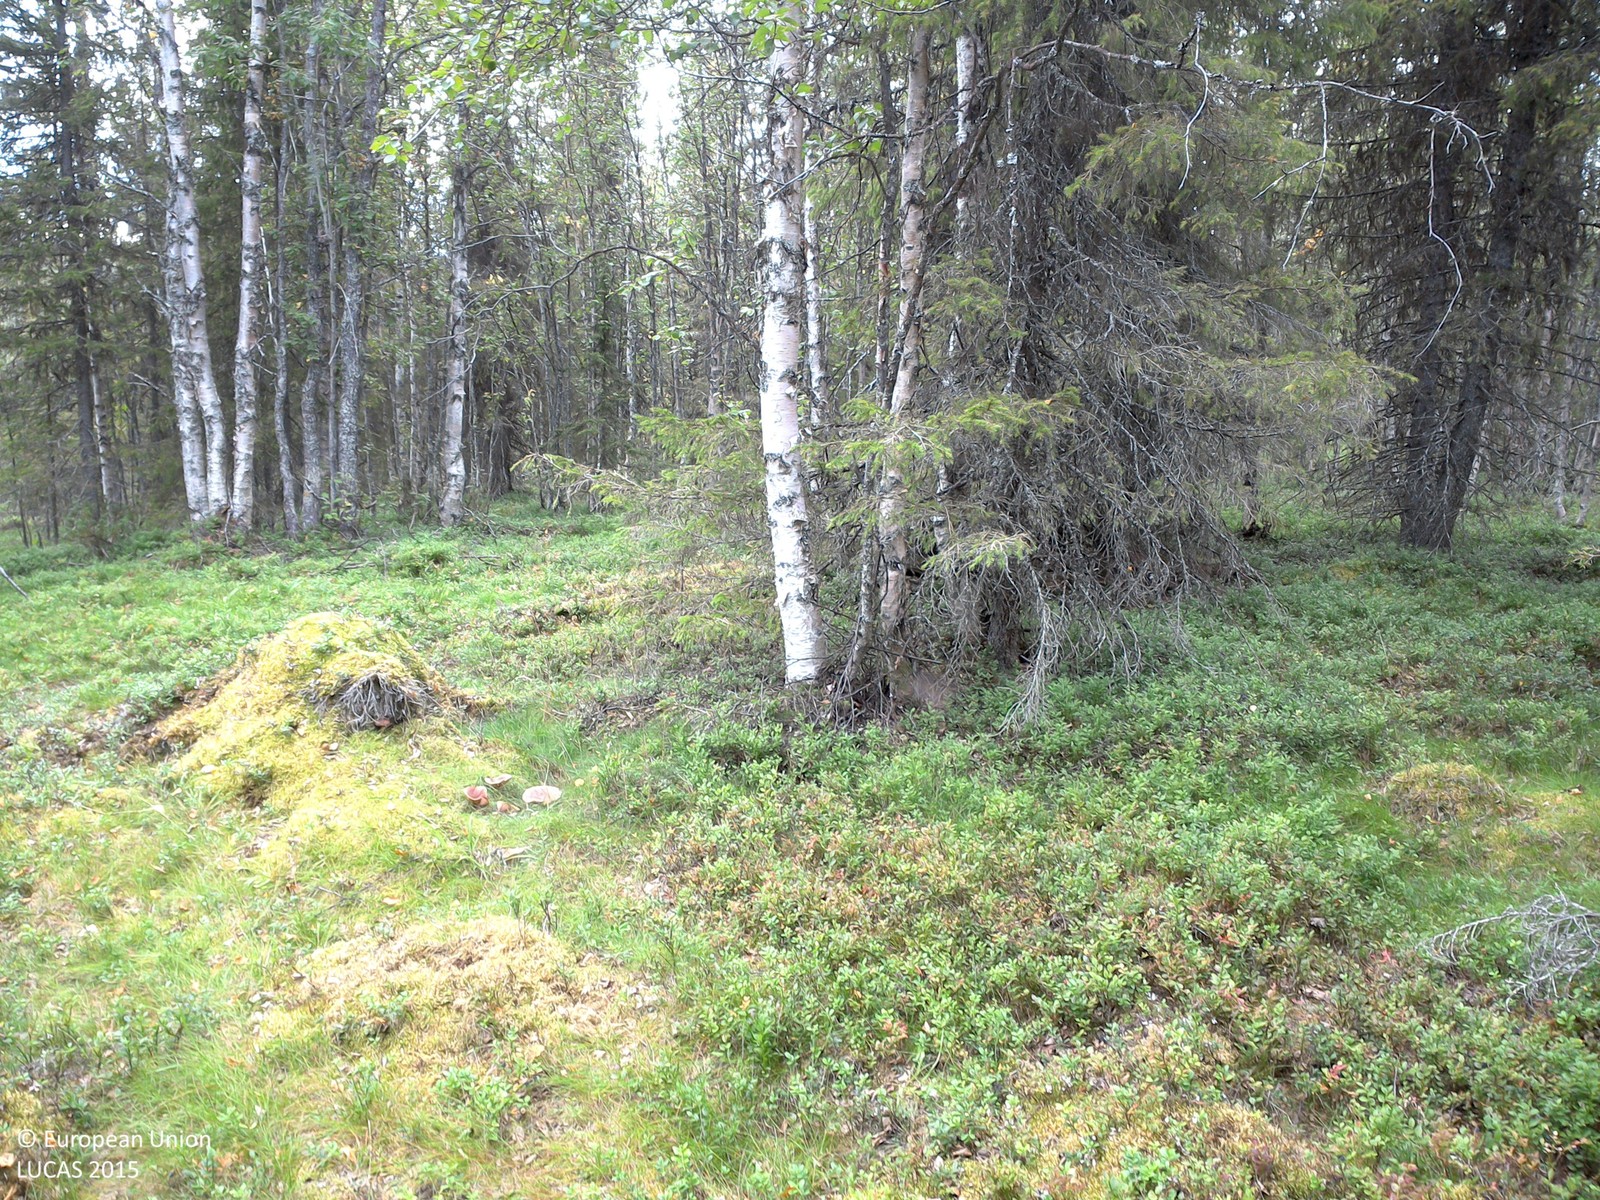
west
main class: Woodland
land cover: Spruce dominated mixed woodland
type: boreal forest
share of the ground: 25 - 50 %
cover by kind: shrubs 50 %, coniferous forest trees 25 %, lichens and mosses 15 %, broadleaved forest trees 10 %
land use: Forestry
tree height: > 5 m
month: August
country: SE
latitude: 67.2824
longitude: 21.9524
